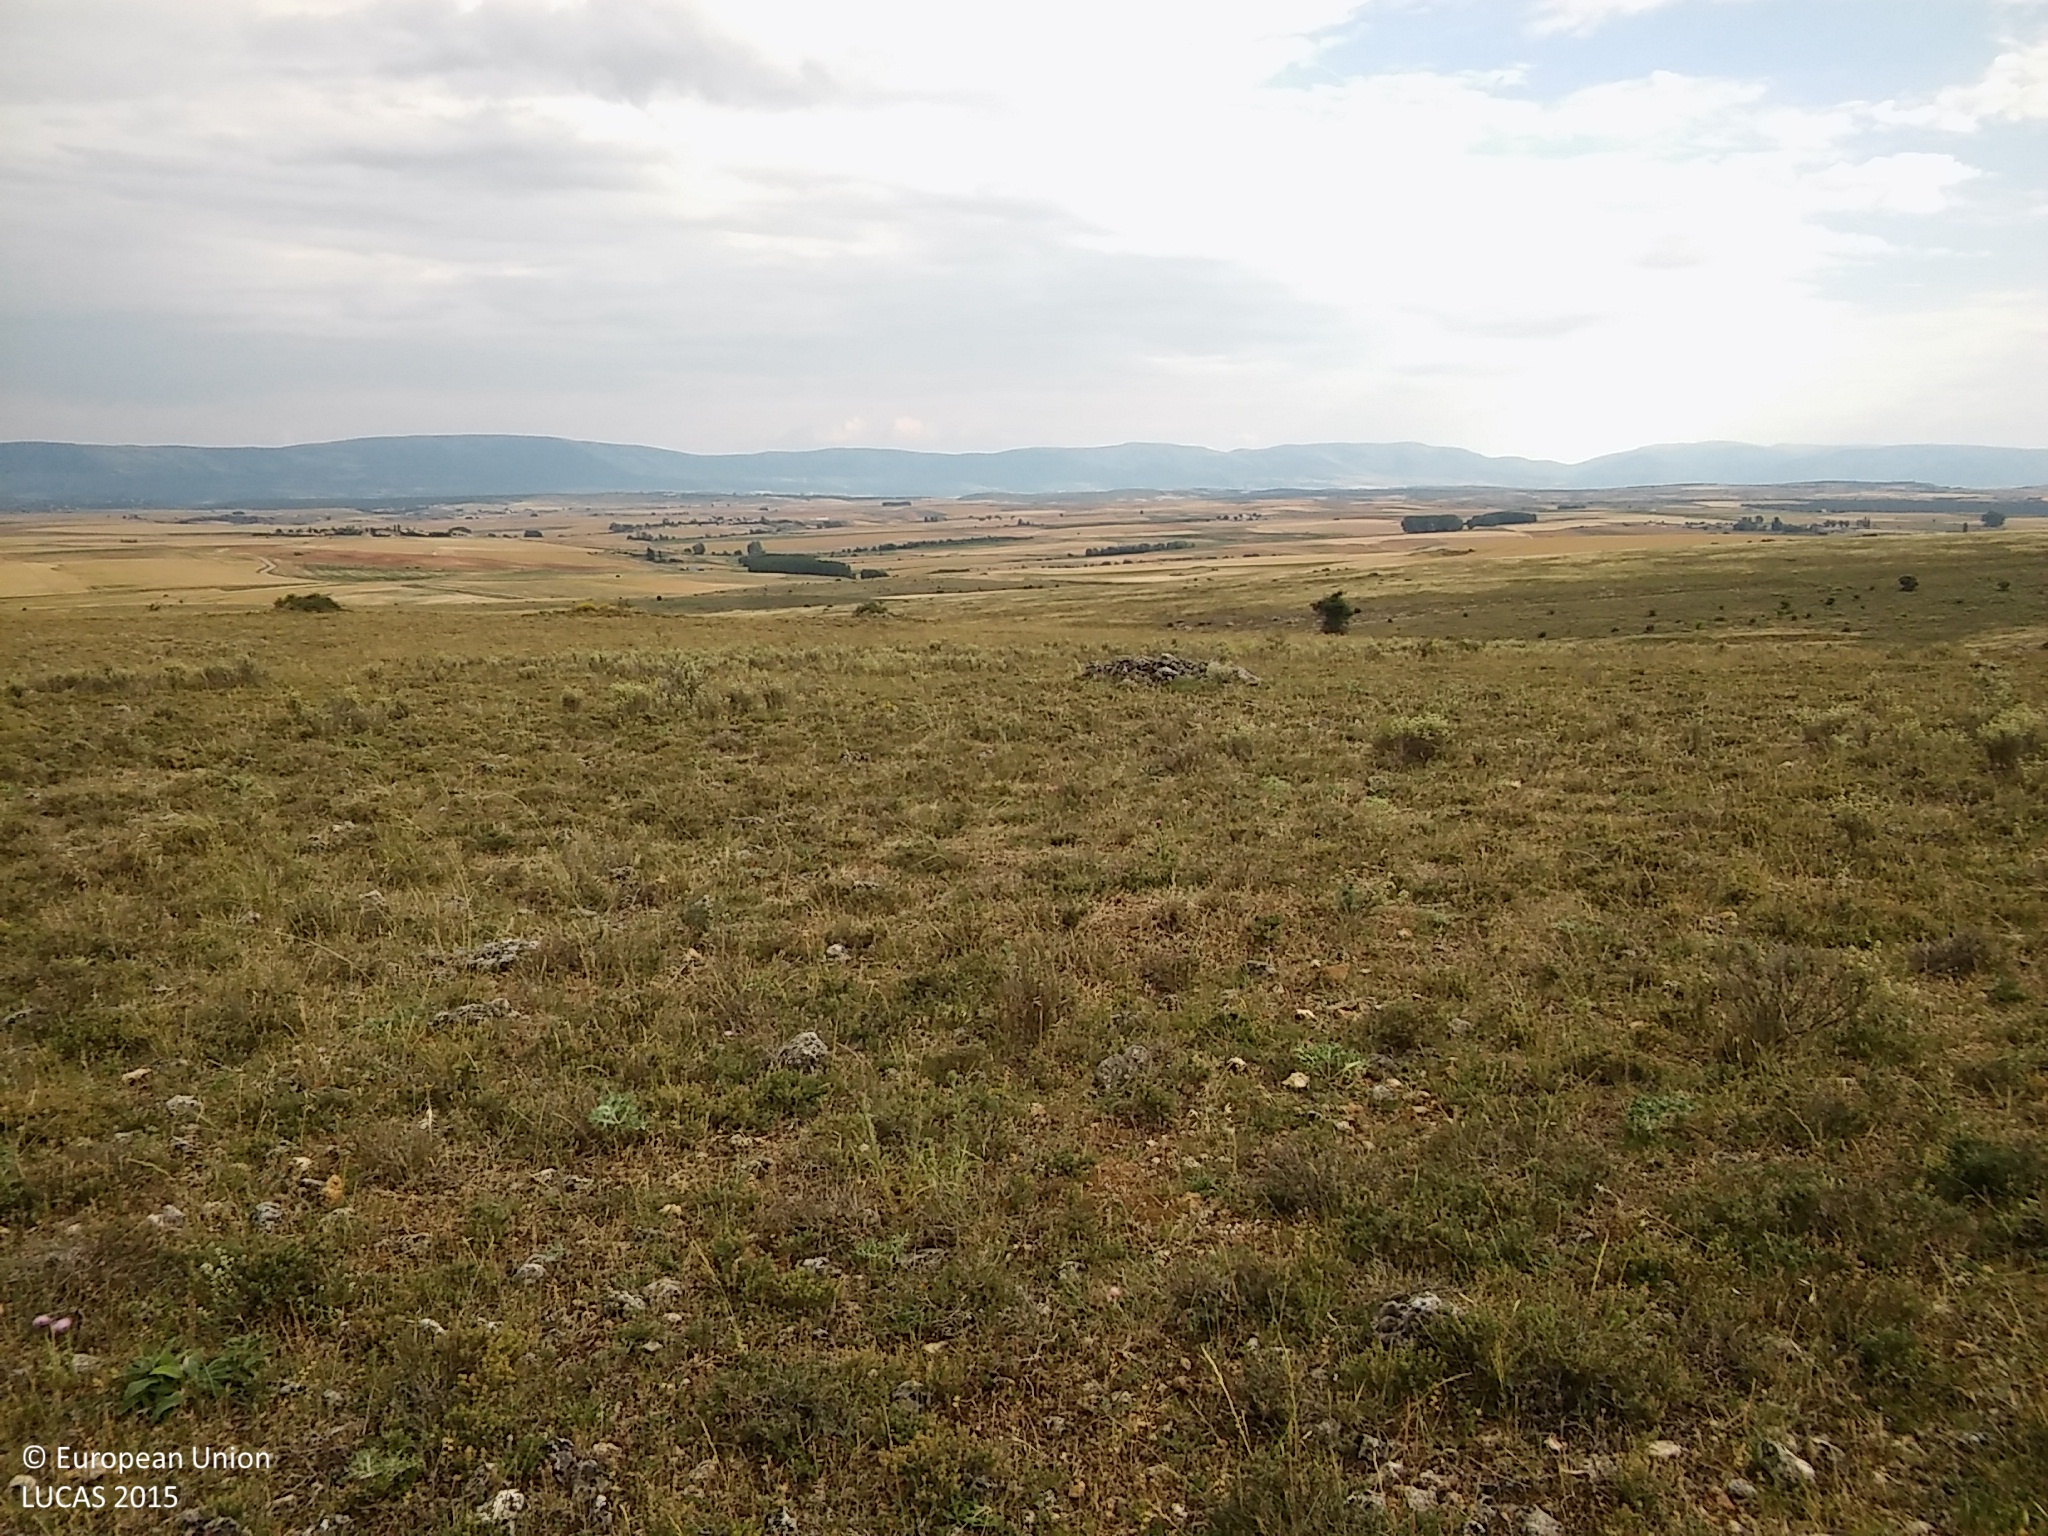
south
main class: Shrubland
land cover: Shrubland without tree cover
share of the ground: 25 - 50 %
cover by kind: shrubs 40 %, lichens and mosses 30 %, unconsolidated bare surface 20 %, herbaceous plants 10 %
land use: Semi-natural and natural areas not in use
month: June
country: ES
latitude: 41.2943
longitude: -3.7221
